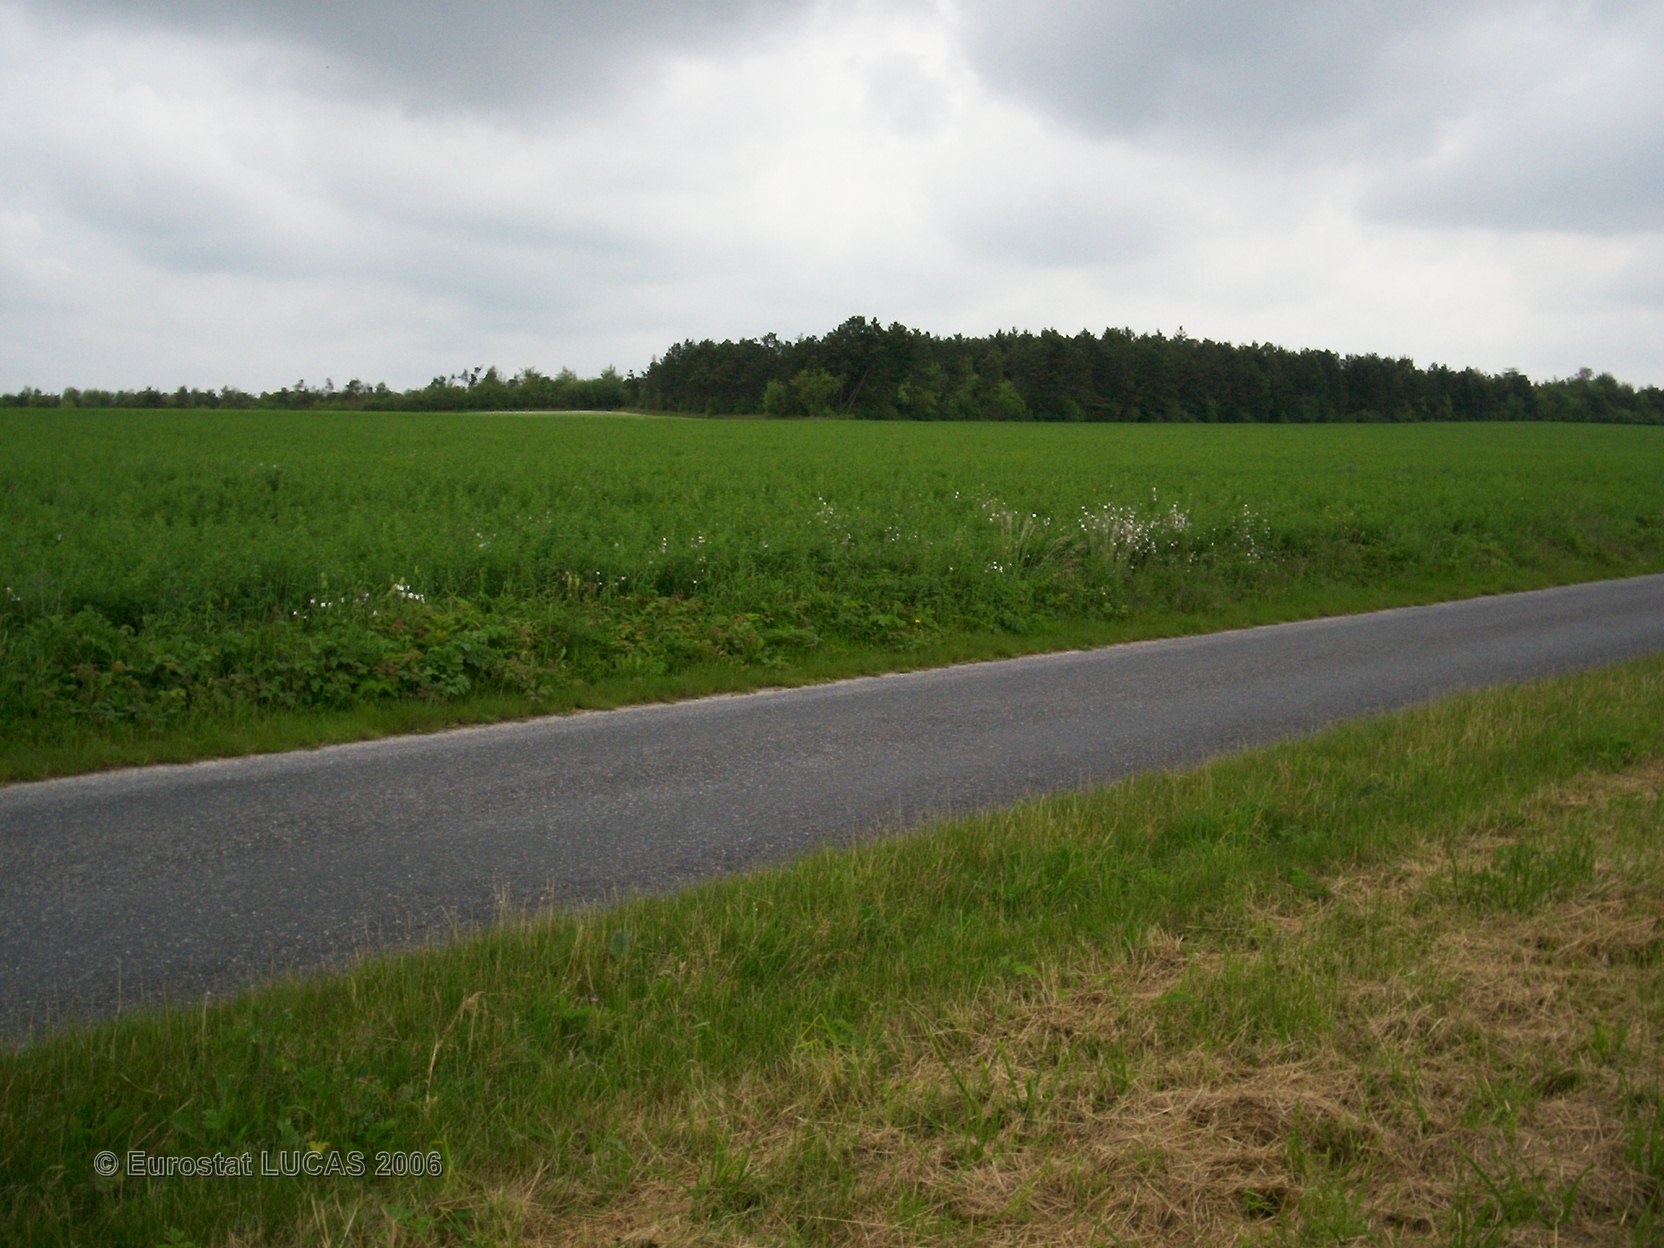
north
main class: Cropland
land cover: Rape and turnip rape
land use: Agriculture (excluding fallow land and kitchen gardens)
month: June
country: FR
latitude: 48.6951
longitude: 4.4129
